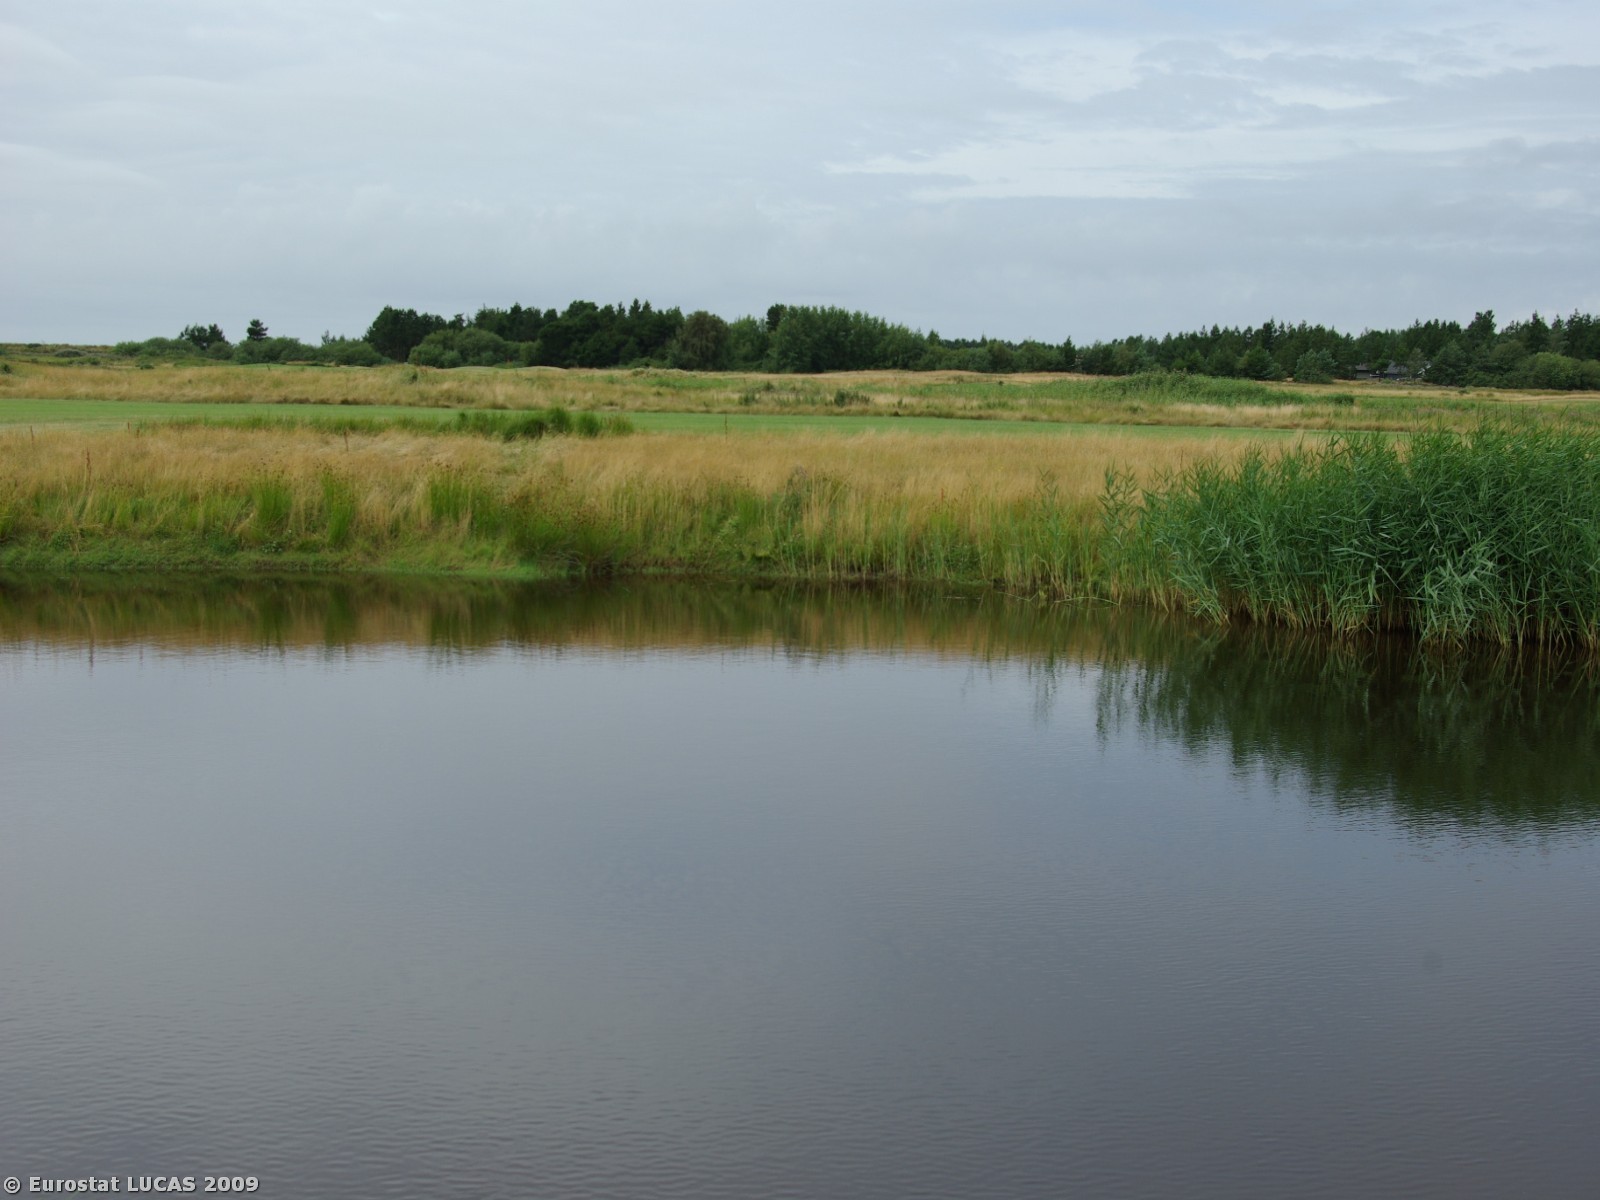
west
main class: Grassland
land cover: Grassland without tree/shrub cover
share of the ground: > 75 %
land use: Sport
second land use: Amenities, museums, leisure
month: July
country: DK
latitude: 55.0829
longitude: 8.5442
